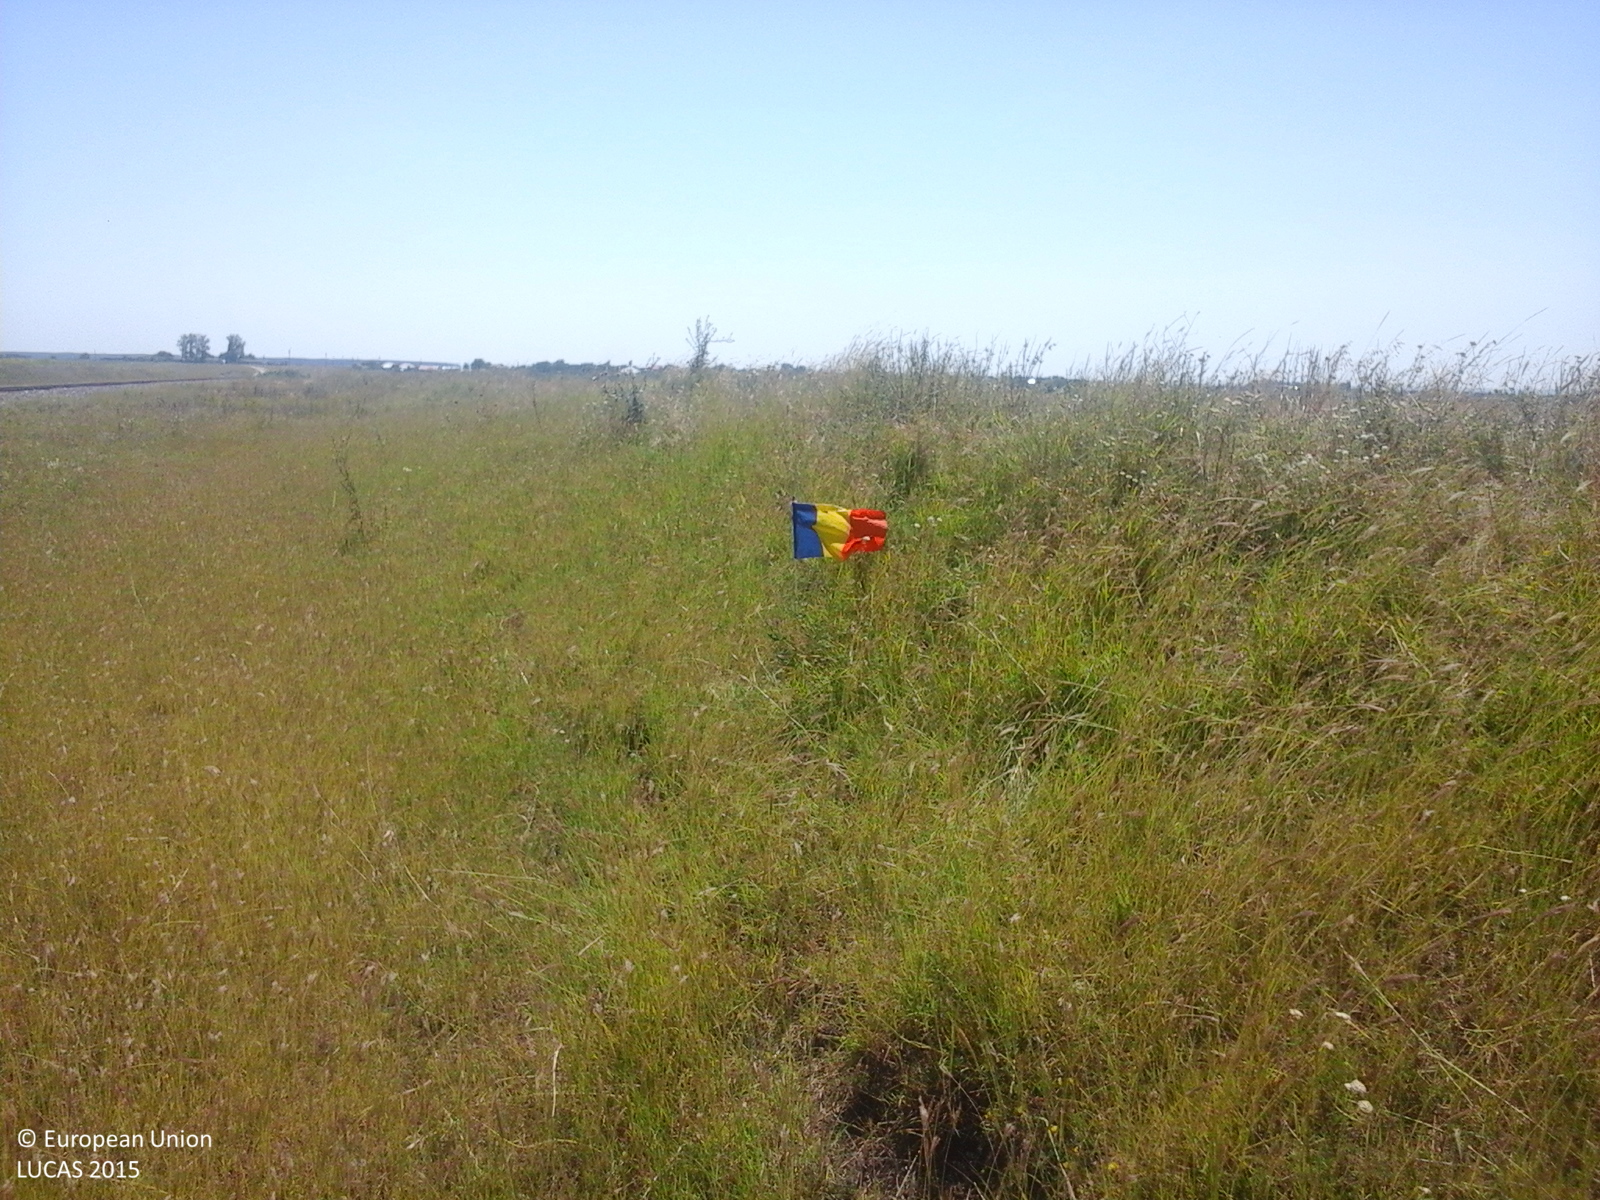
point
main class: Grassland
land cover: Spontaneously vegetated surfaces
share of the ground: > 75 %
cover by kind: herbaceous plants 100 %
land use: Fallow land
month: July
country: RO
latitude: 44.2196
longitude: 26.5746
